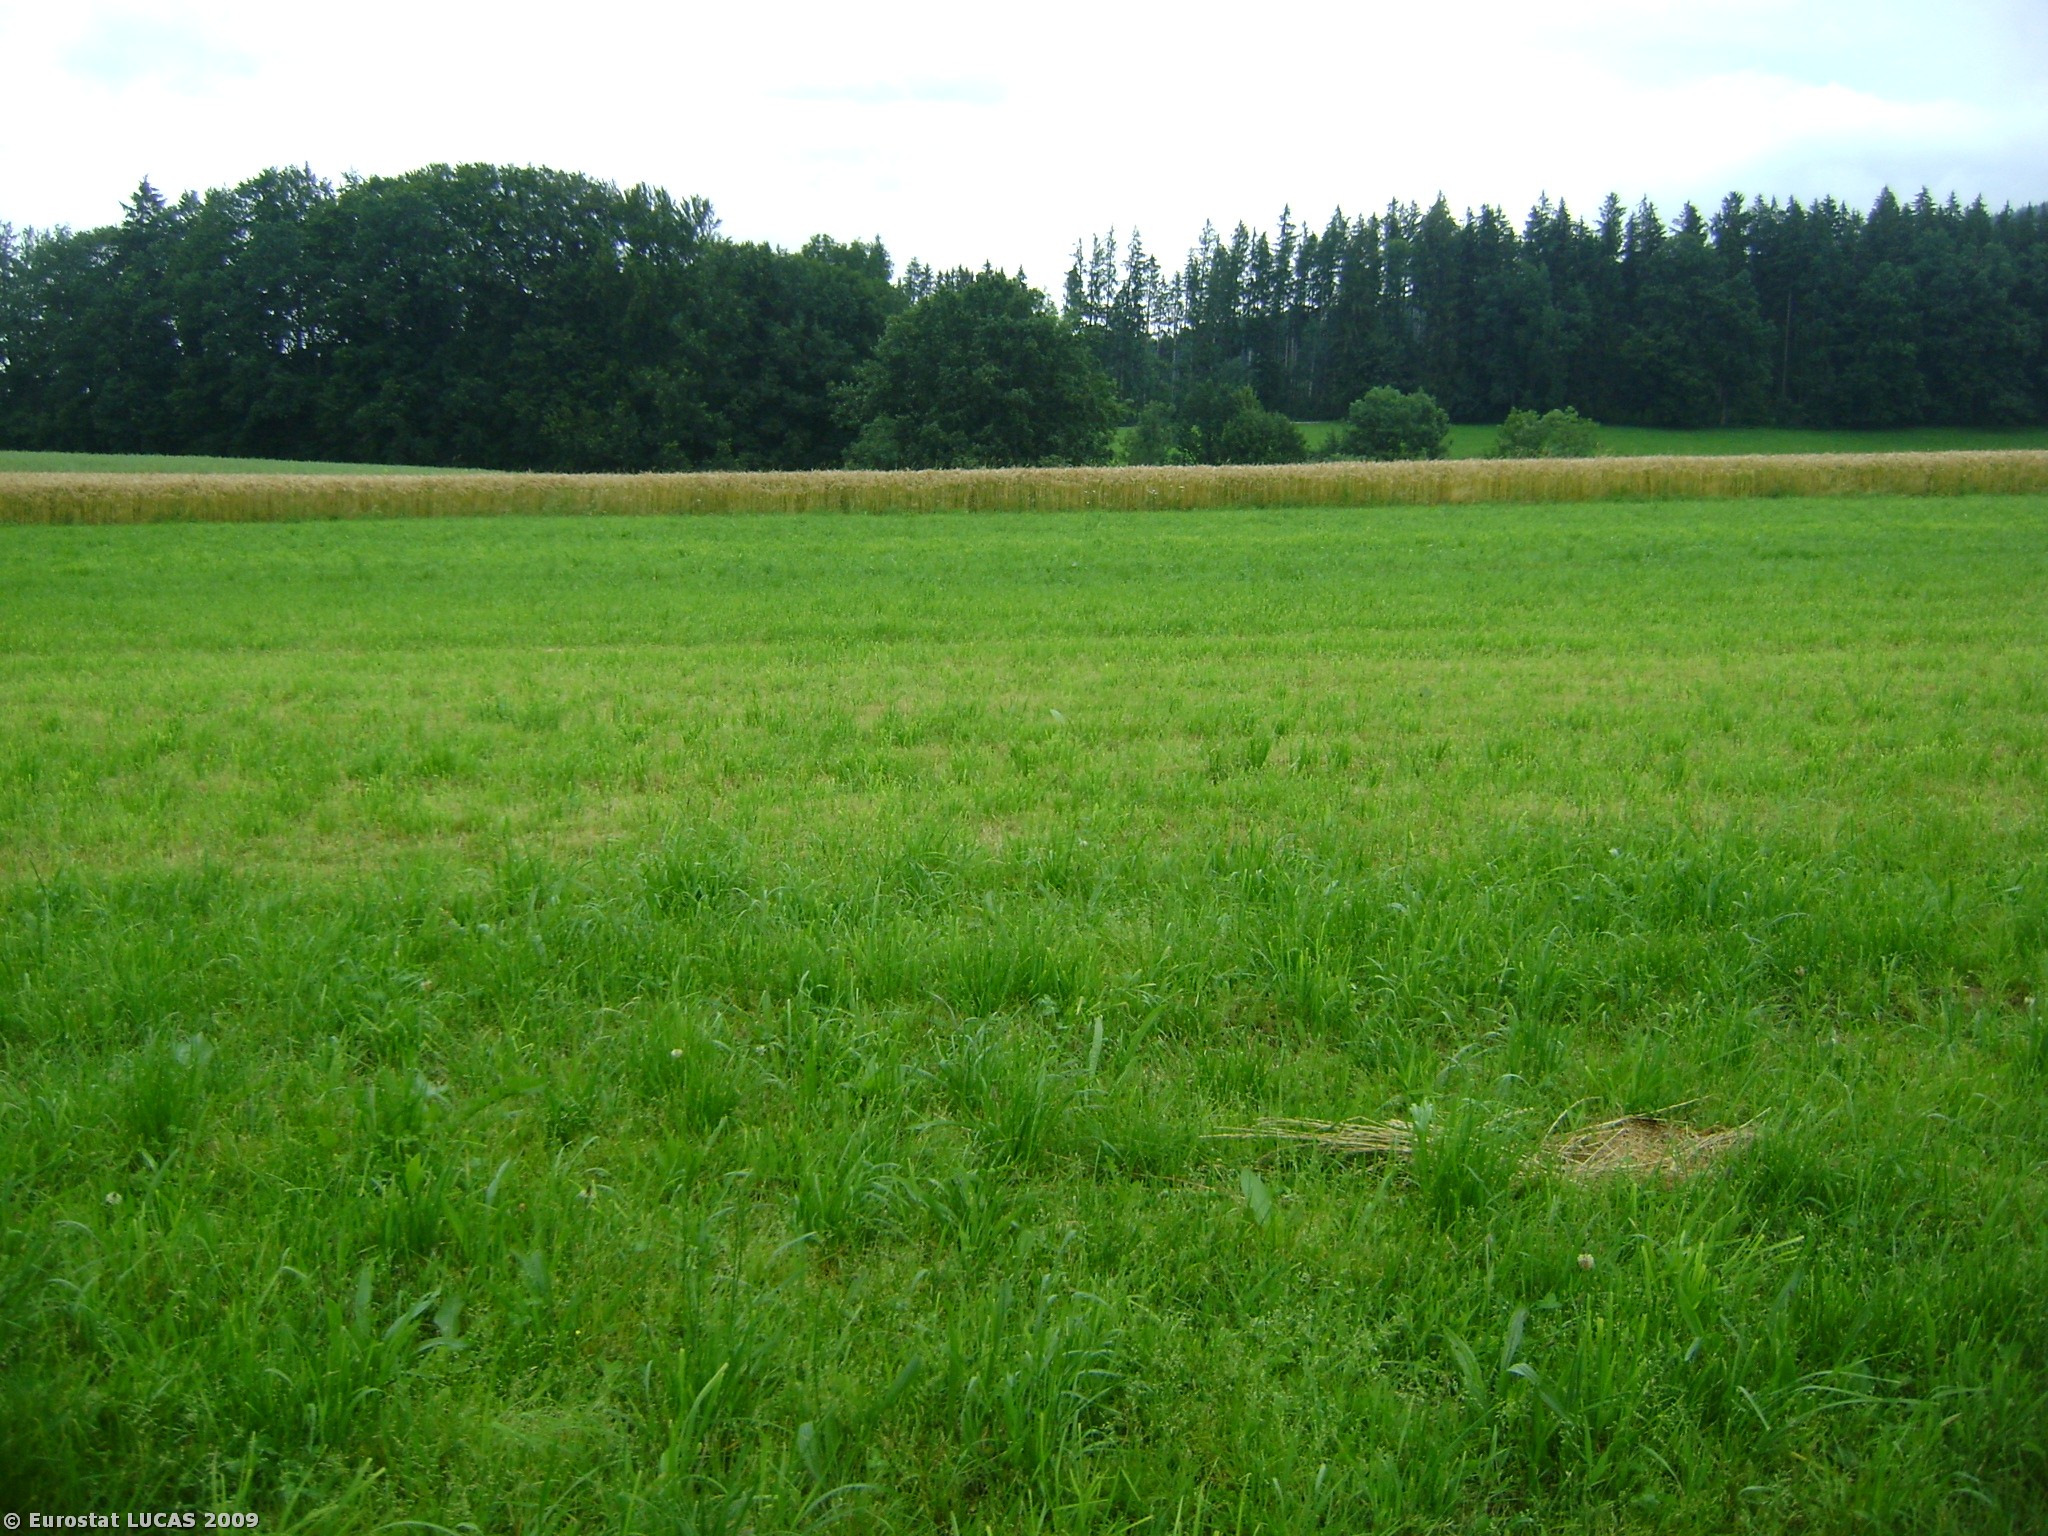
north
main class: Grassland
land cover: Grassland without tree/shrub cover
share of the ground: > 75 %
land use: Agriculture (excluding fallow land and kitchen gardens)
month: July
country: AT
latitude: 47.9415
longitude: 13.2520
